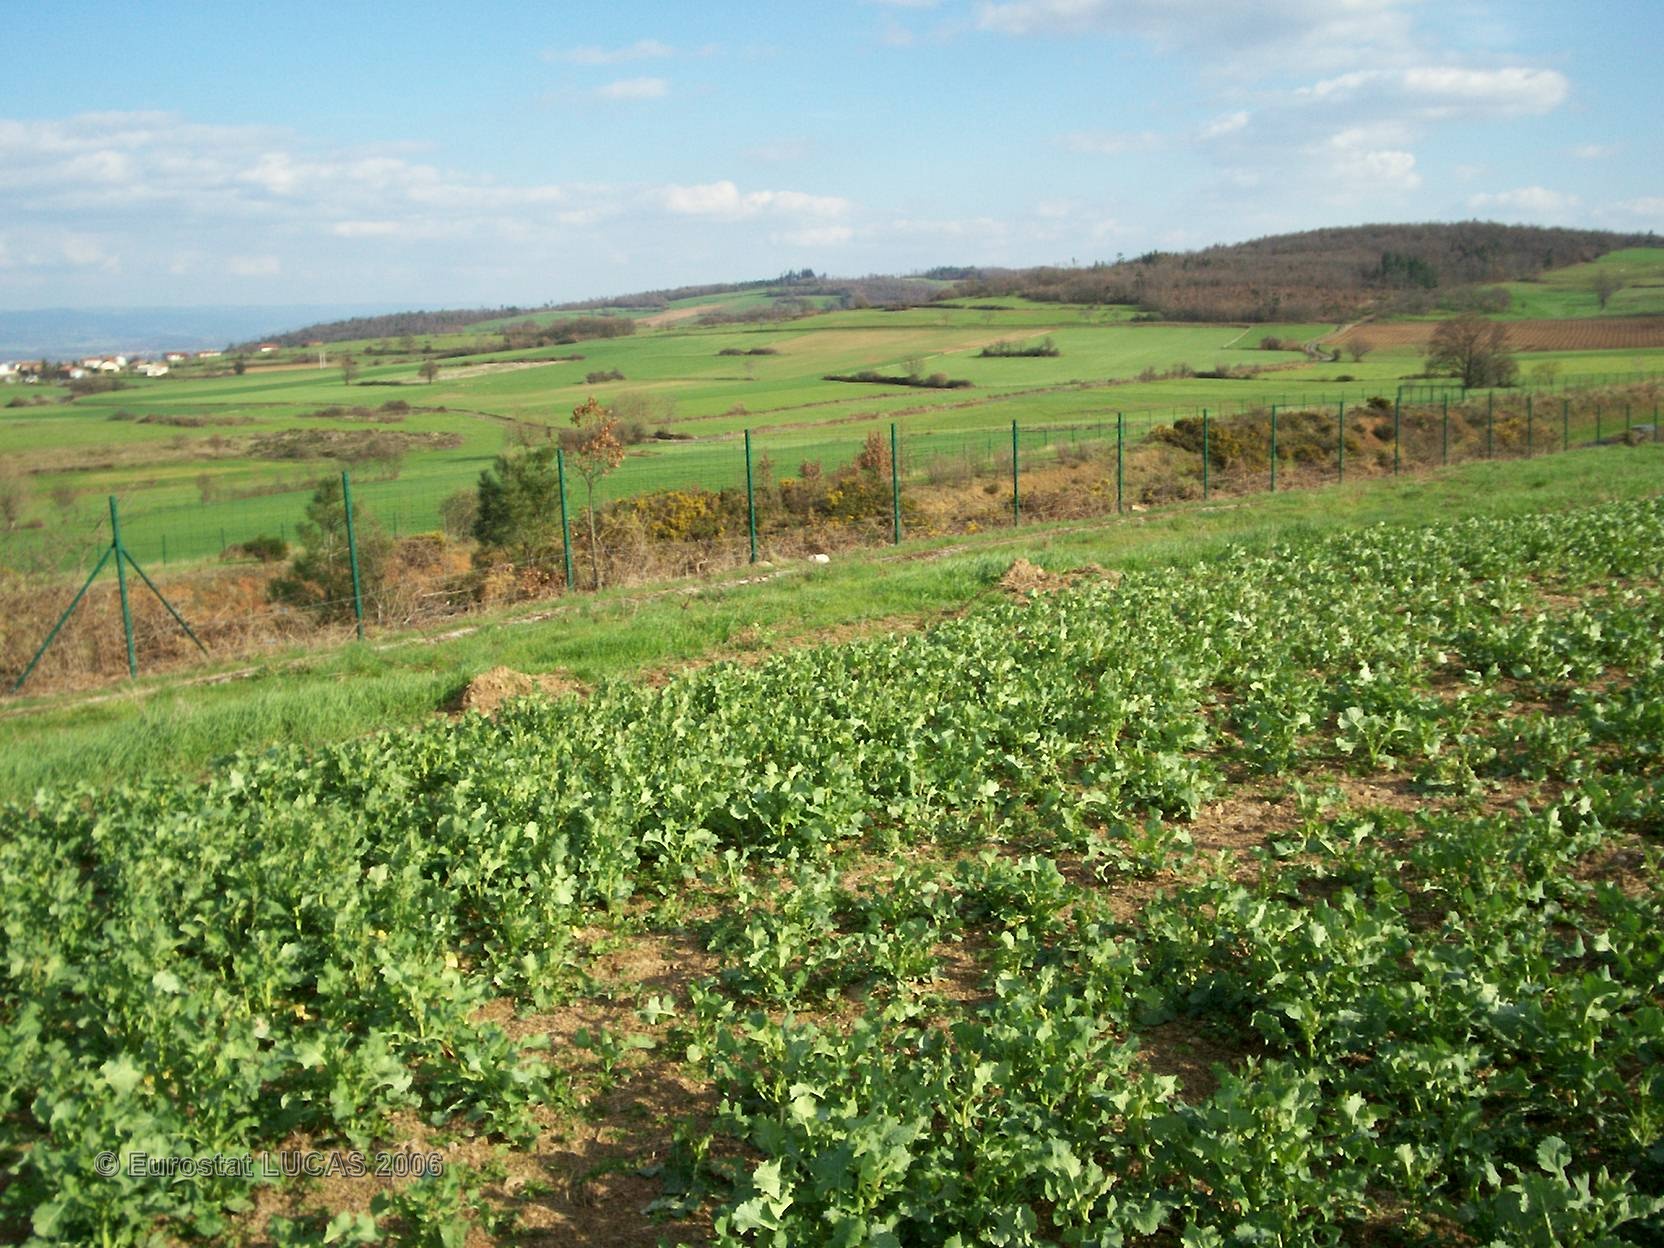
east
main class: Cropland
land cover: Rape and turnip rape
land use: Agriculture (excluding fallow land and kitchen gardens)
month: April
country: FR
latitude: 45.3442
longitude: 3.2759
